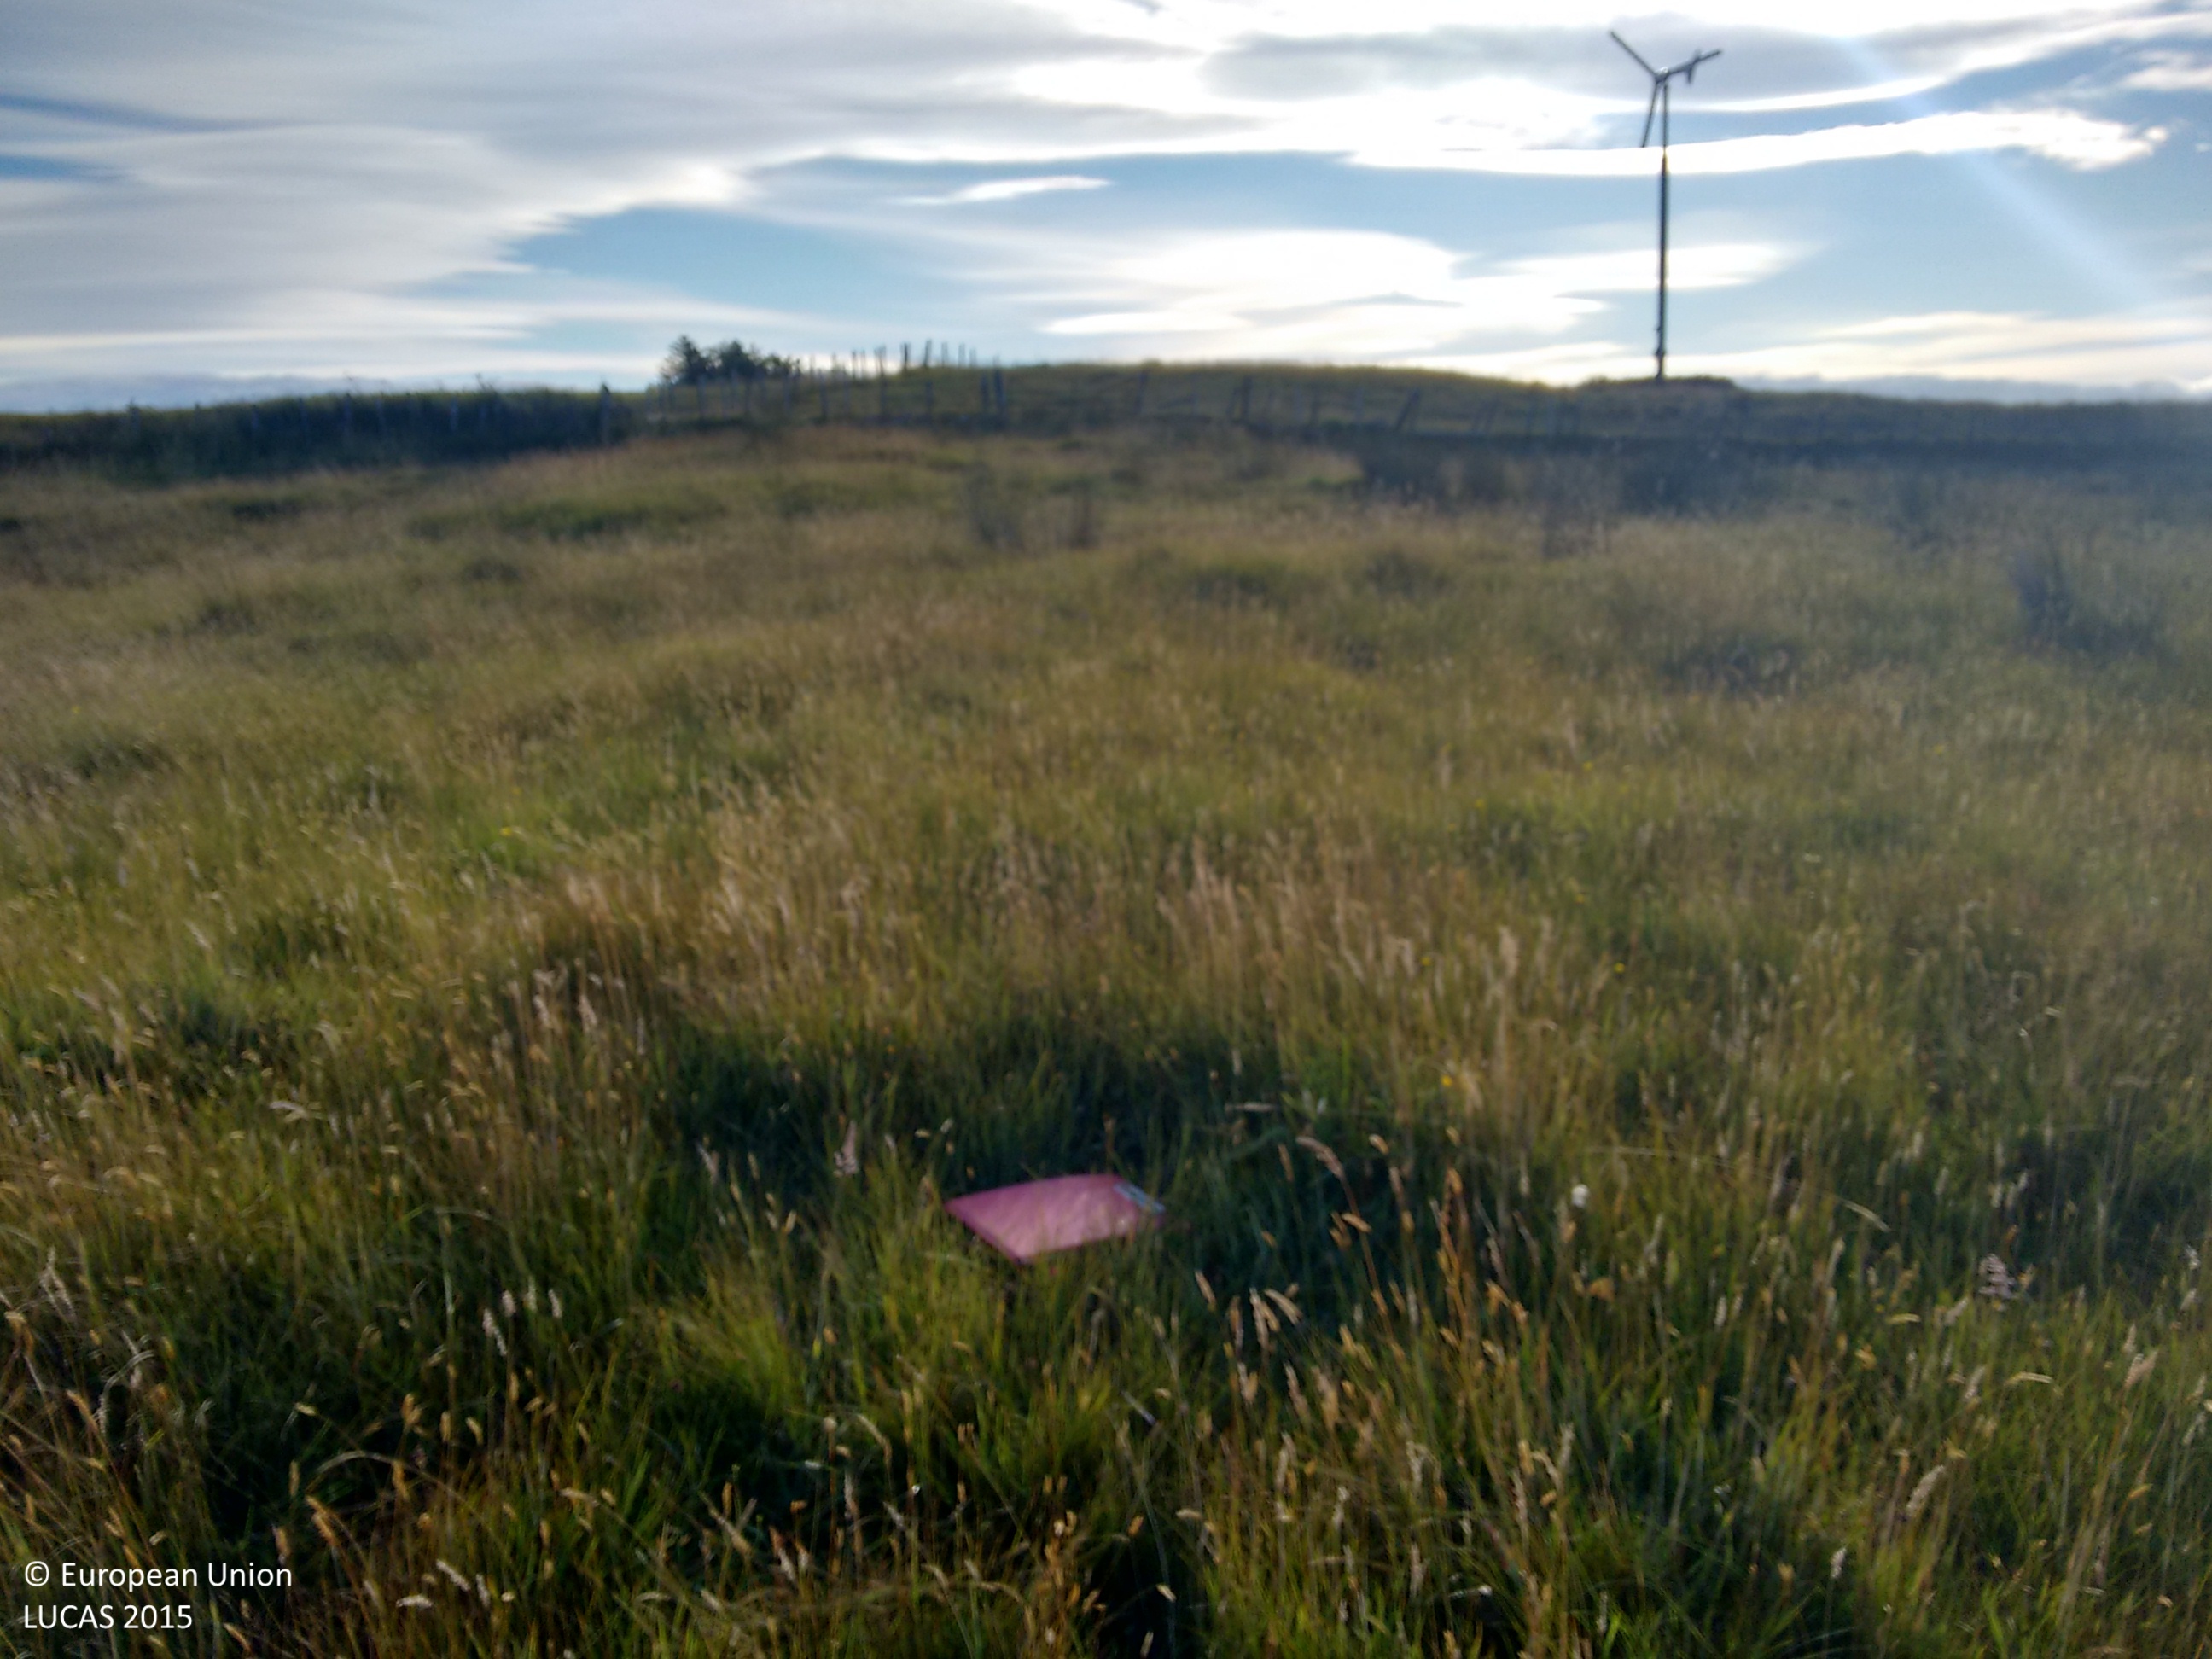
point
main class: Grassland
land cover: Grassland without tree/shrub cover
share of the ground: > 75 %
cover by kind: herbaceous plants 100 %
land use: Agriculture (excluding fallow land and kitchen gardens)
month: September
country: GB
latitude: 58.0428
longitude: -4.3996
